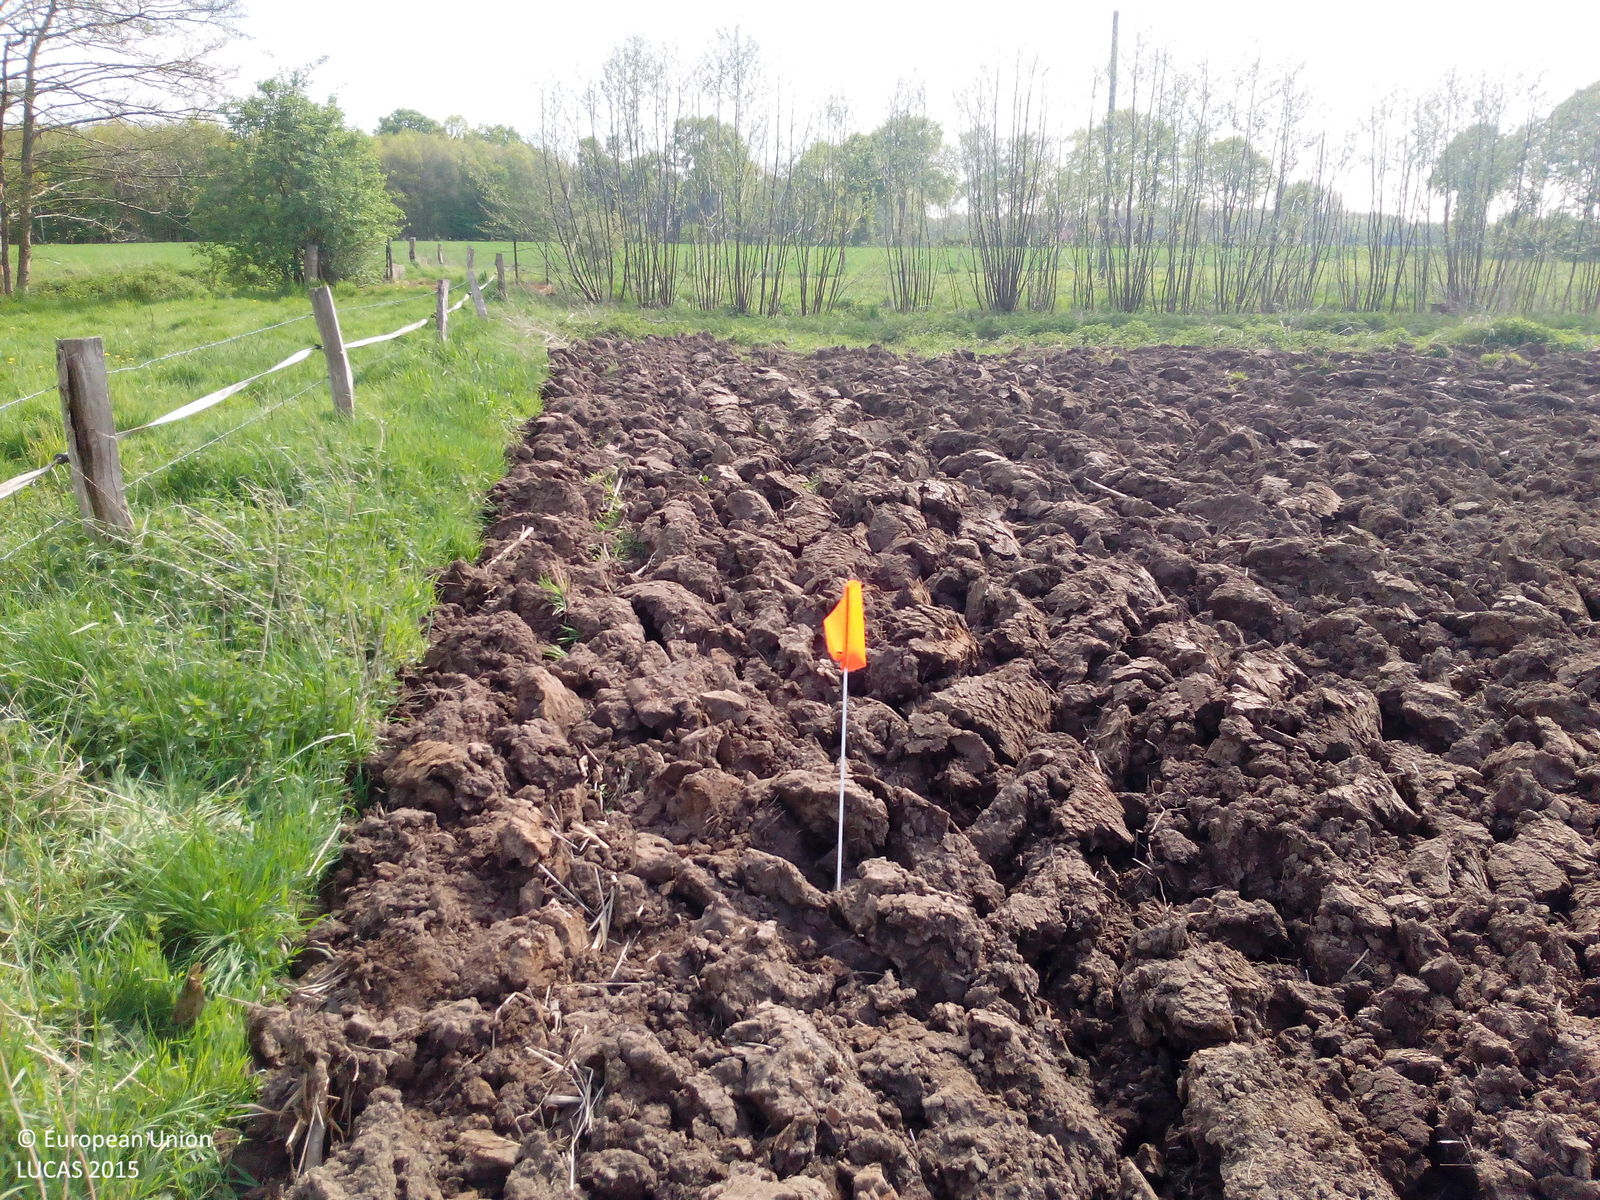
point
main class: Cropland
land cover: Maize
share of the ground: < 10 %
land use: Agriculture (excluding fallow land and kitchen gardens)
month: May
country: DE
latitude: 51.8276
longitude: 7.4030
